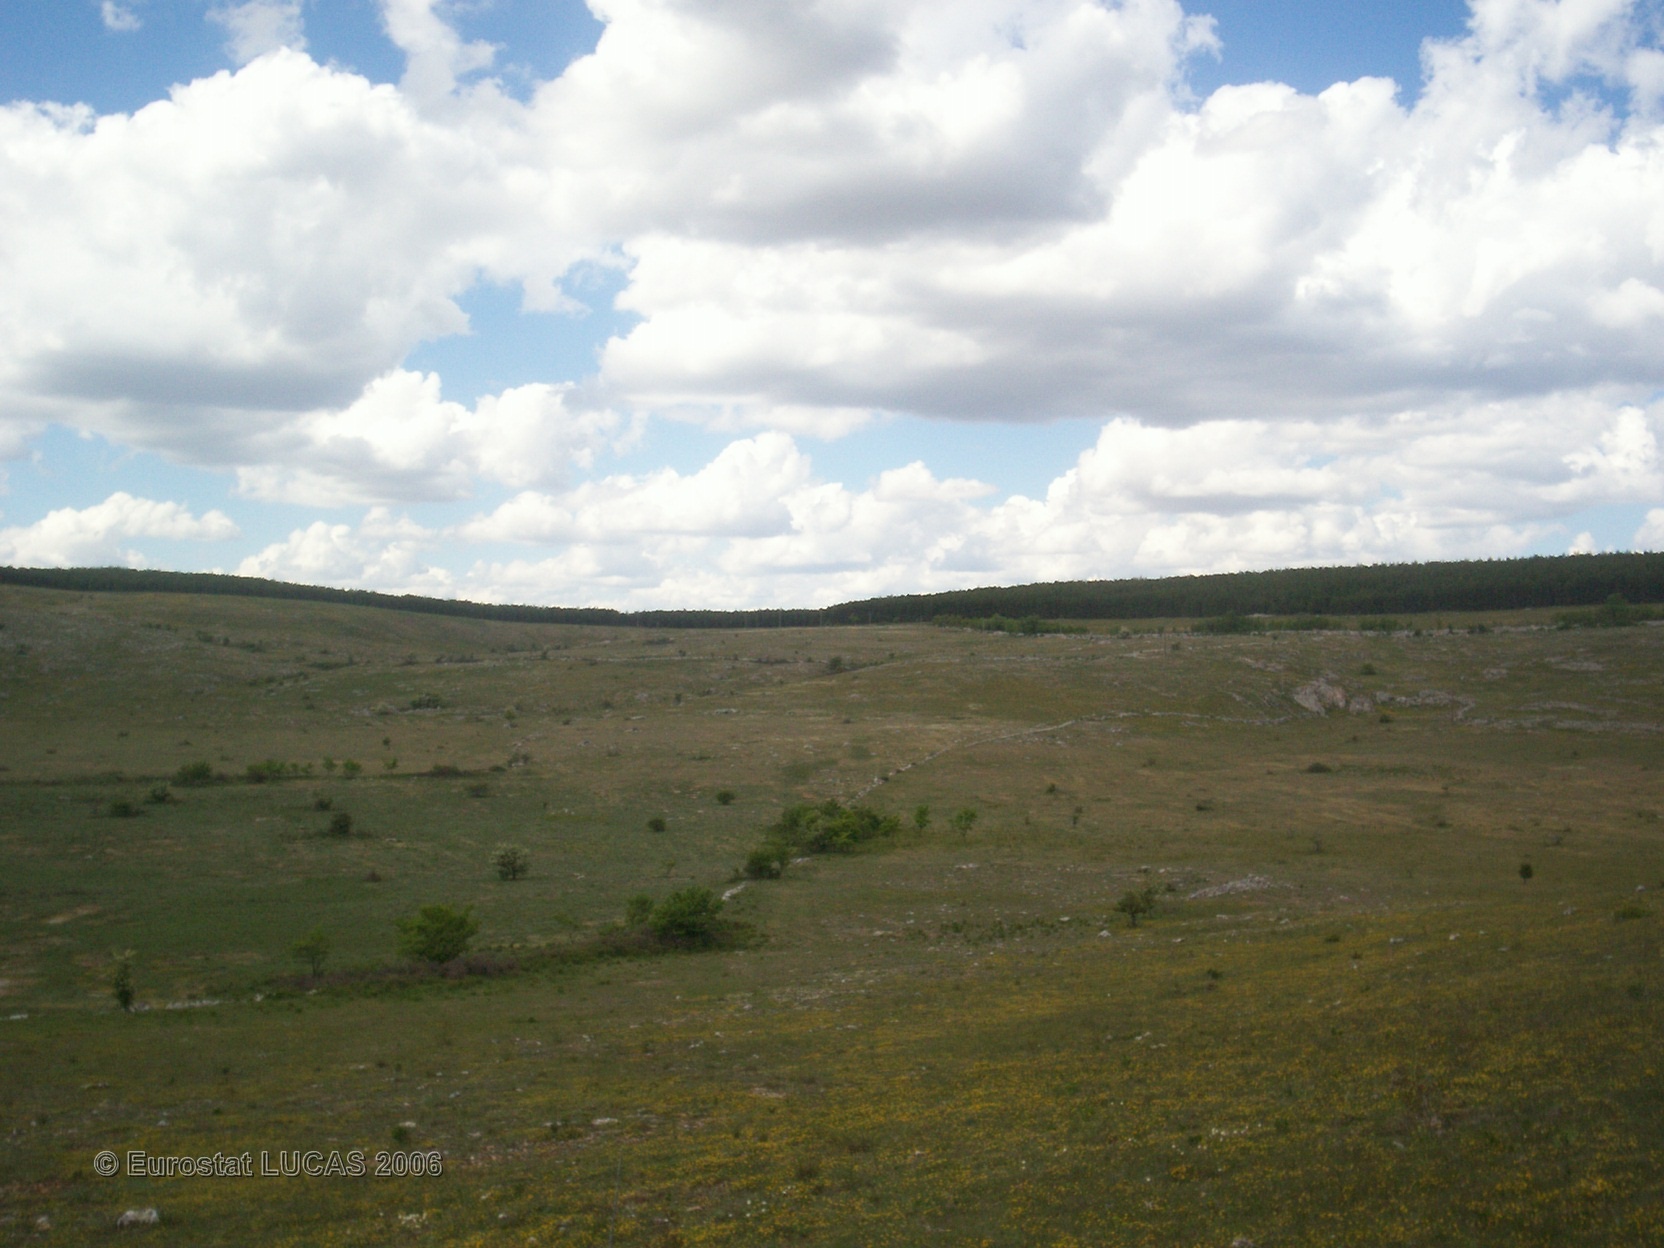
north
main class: Grassland
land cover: Grassland without tree/shrub cover
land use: Agriculture (excluding fallow land and kitchen gardens)
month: June
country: FR
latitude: 44.2329
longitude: 3.4331
